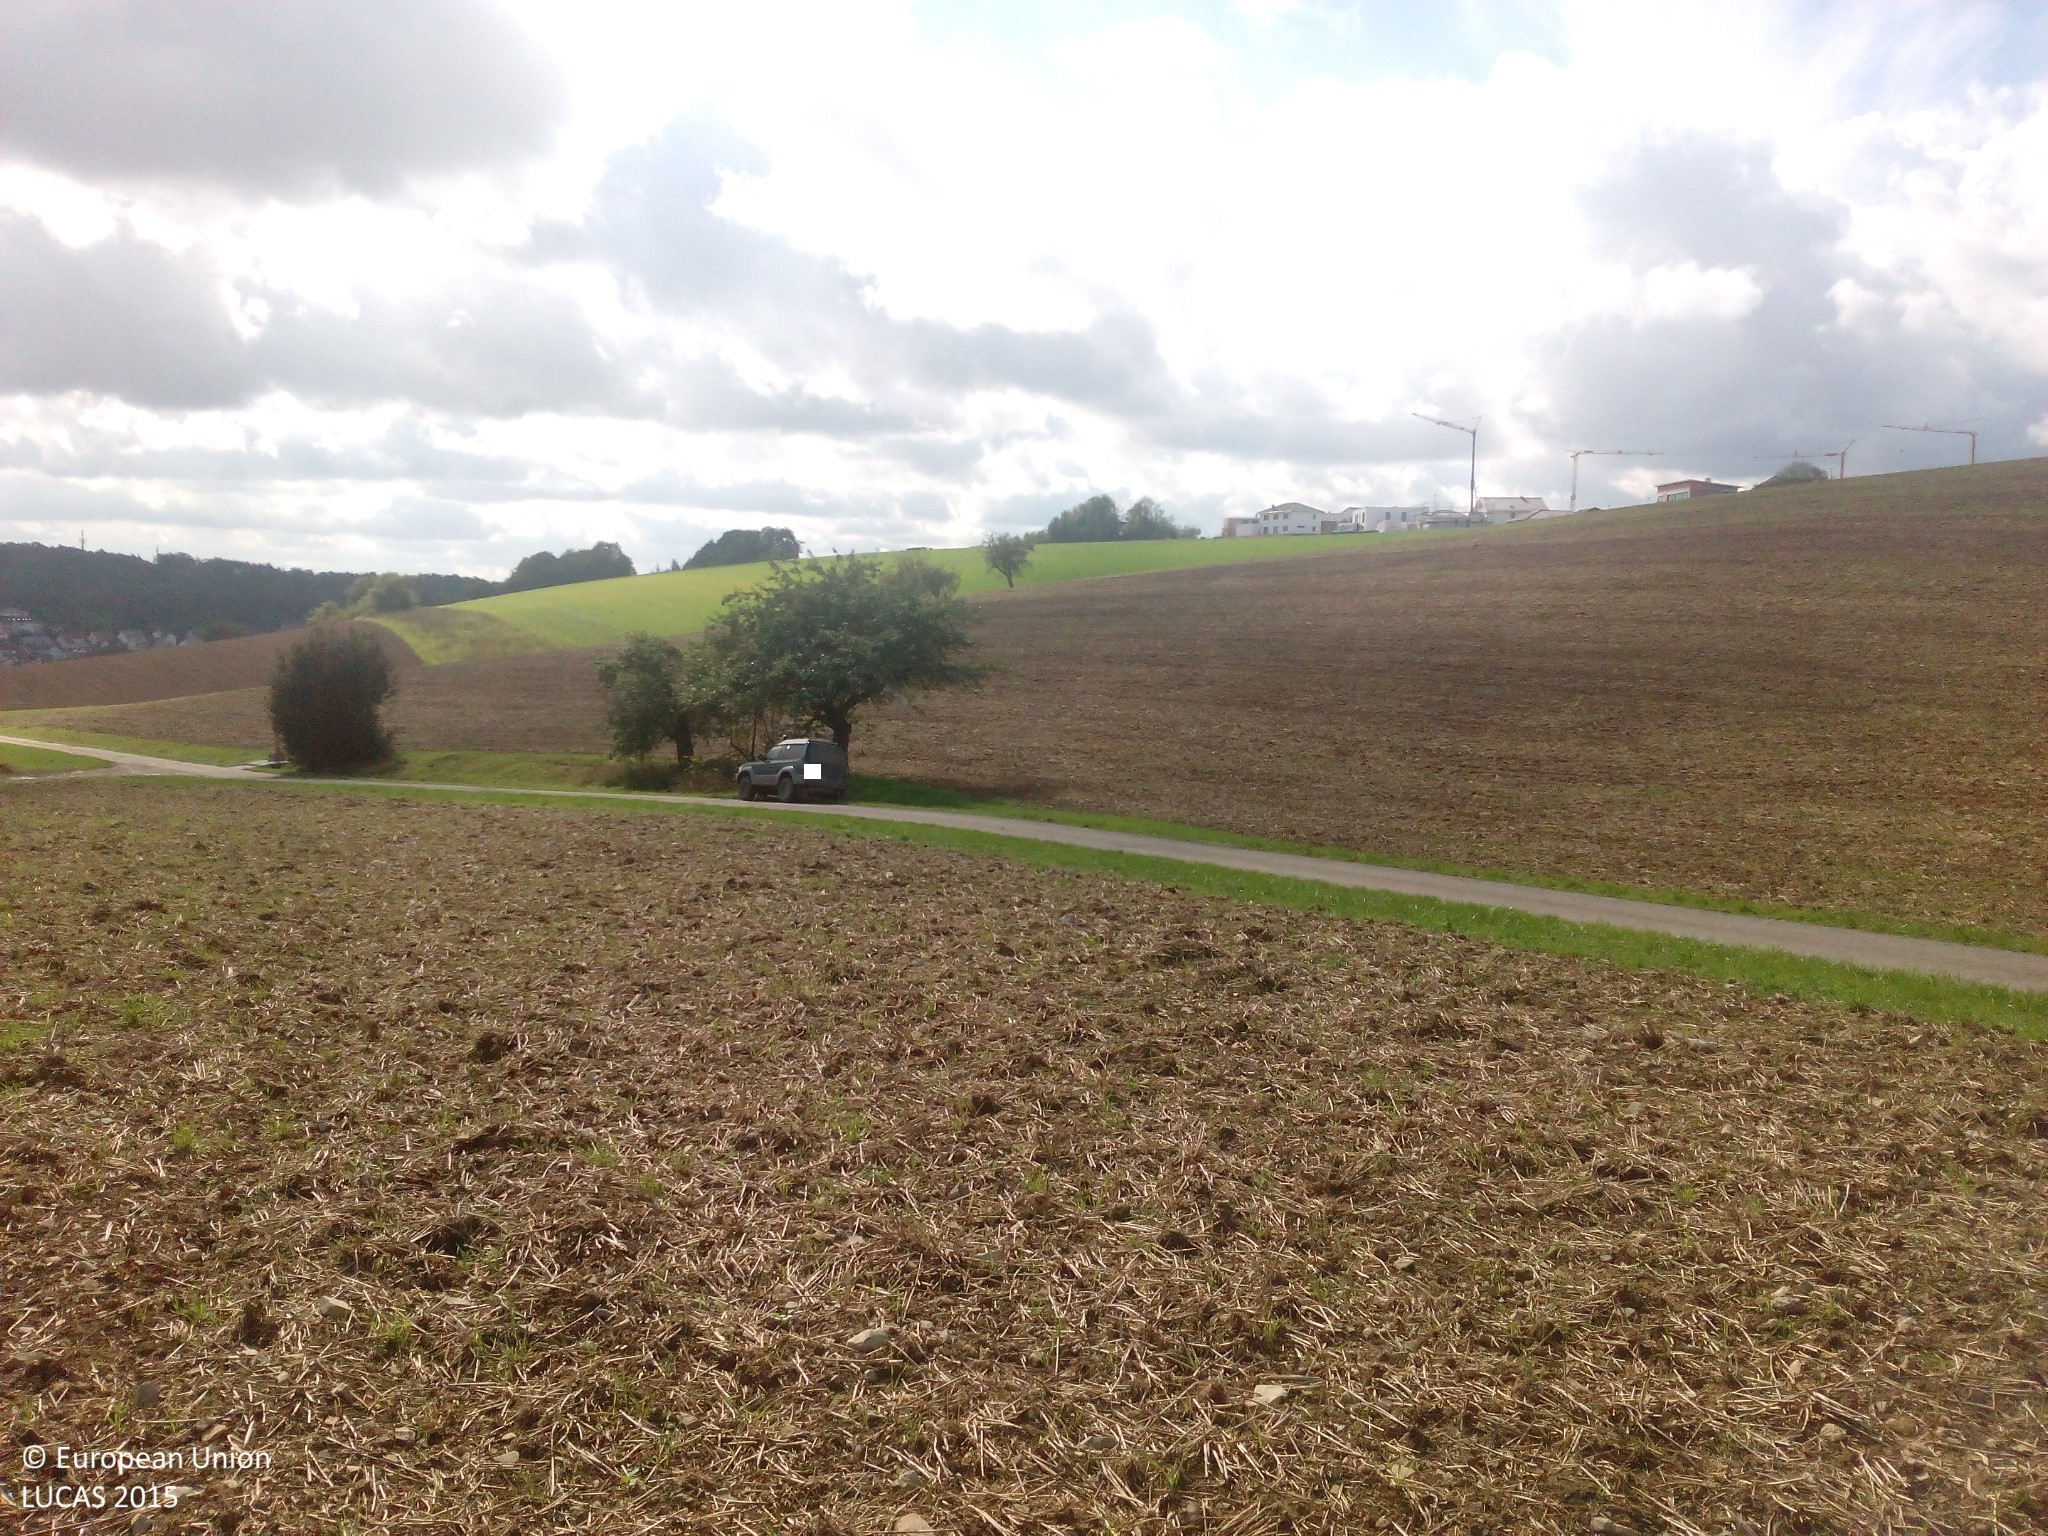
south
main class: Cropland
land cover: Common wheat
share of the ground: 10 - 25 %
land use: Agriculture (excluding fallow land and kitchen gardens)
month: September
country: DE
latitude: 49.8785
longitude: 9.9026
